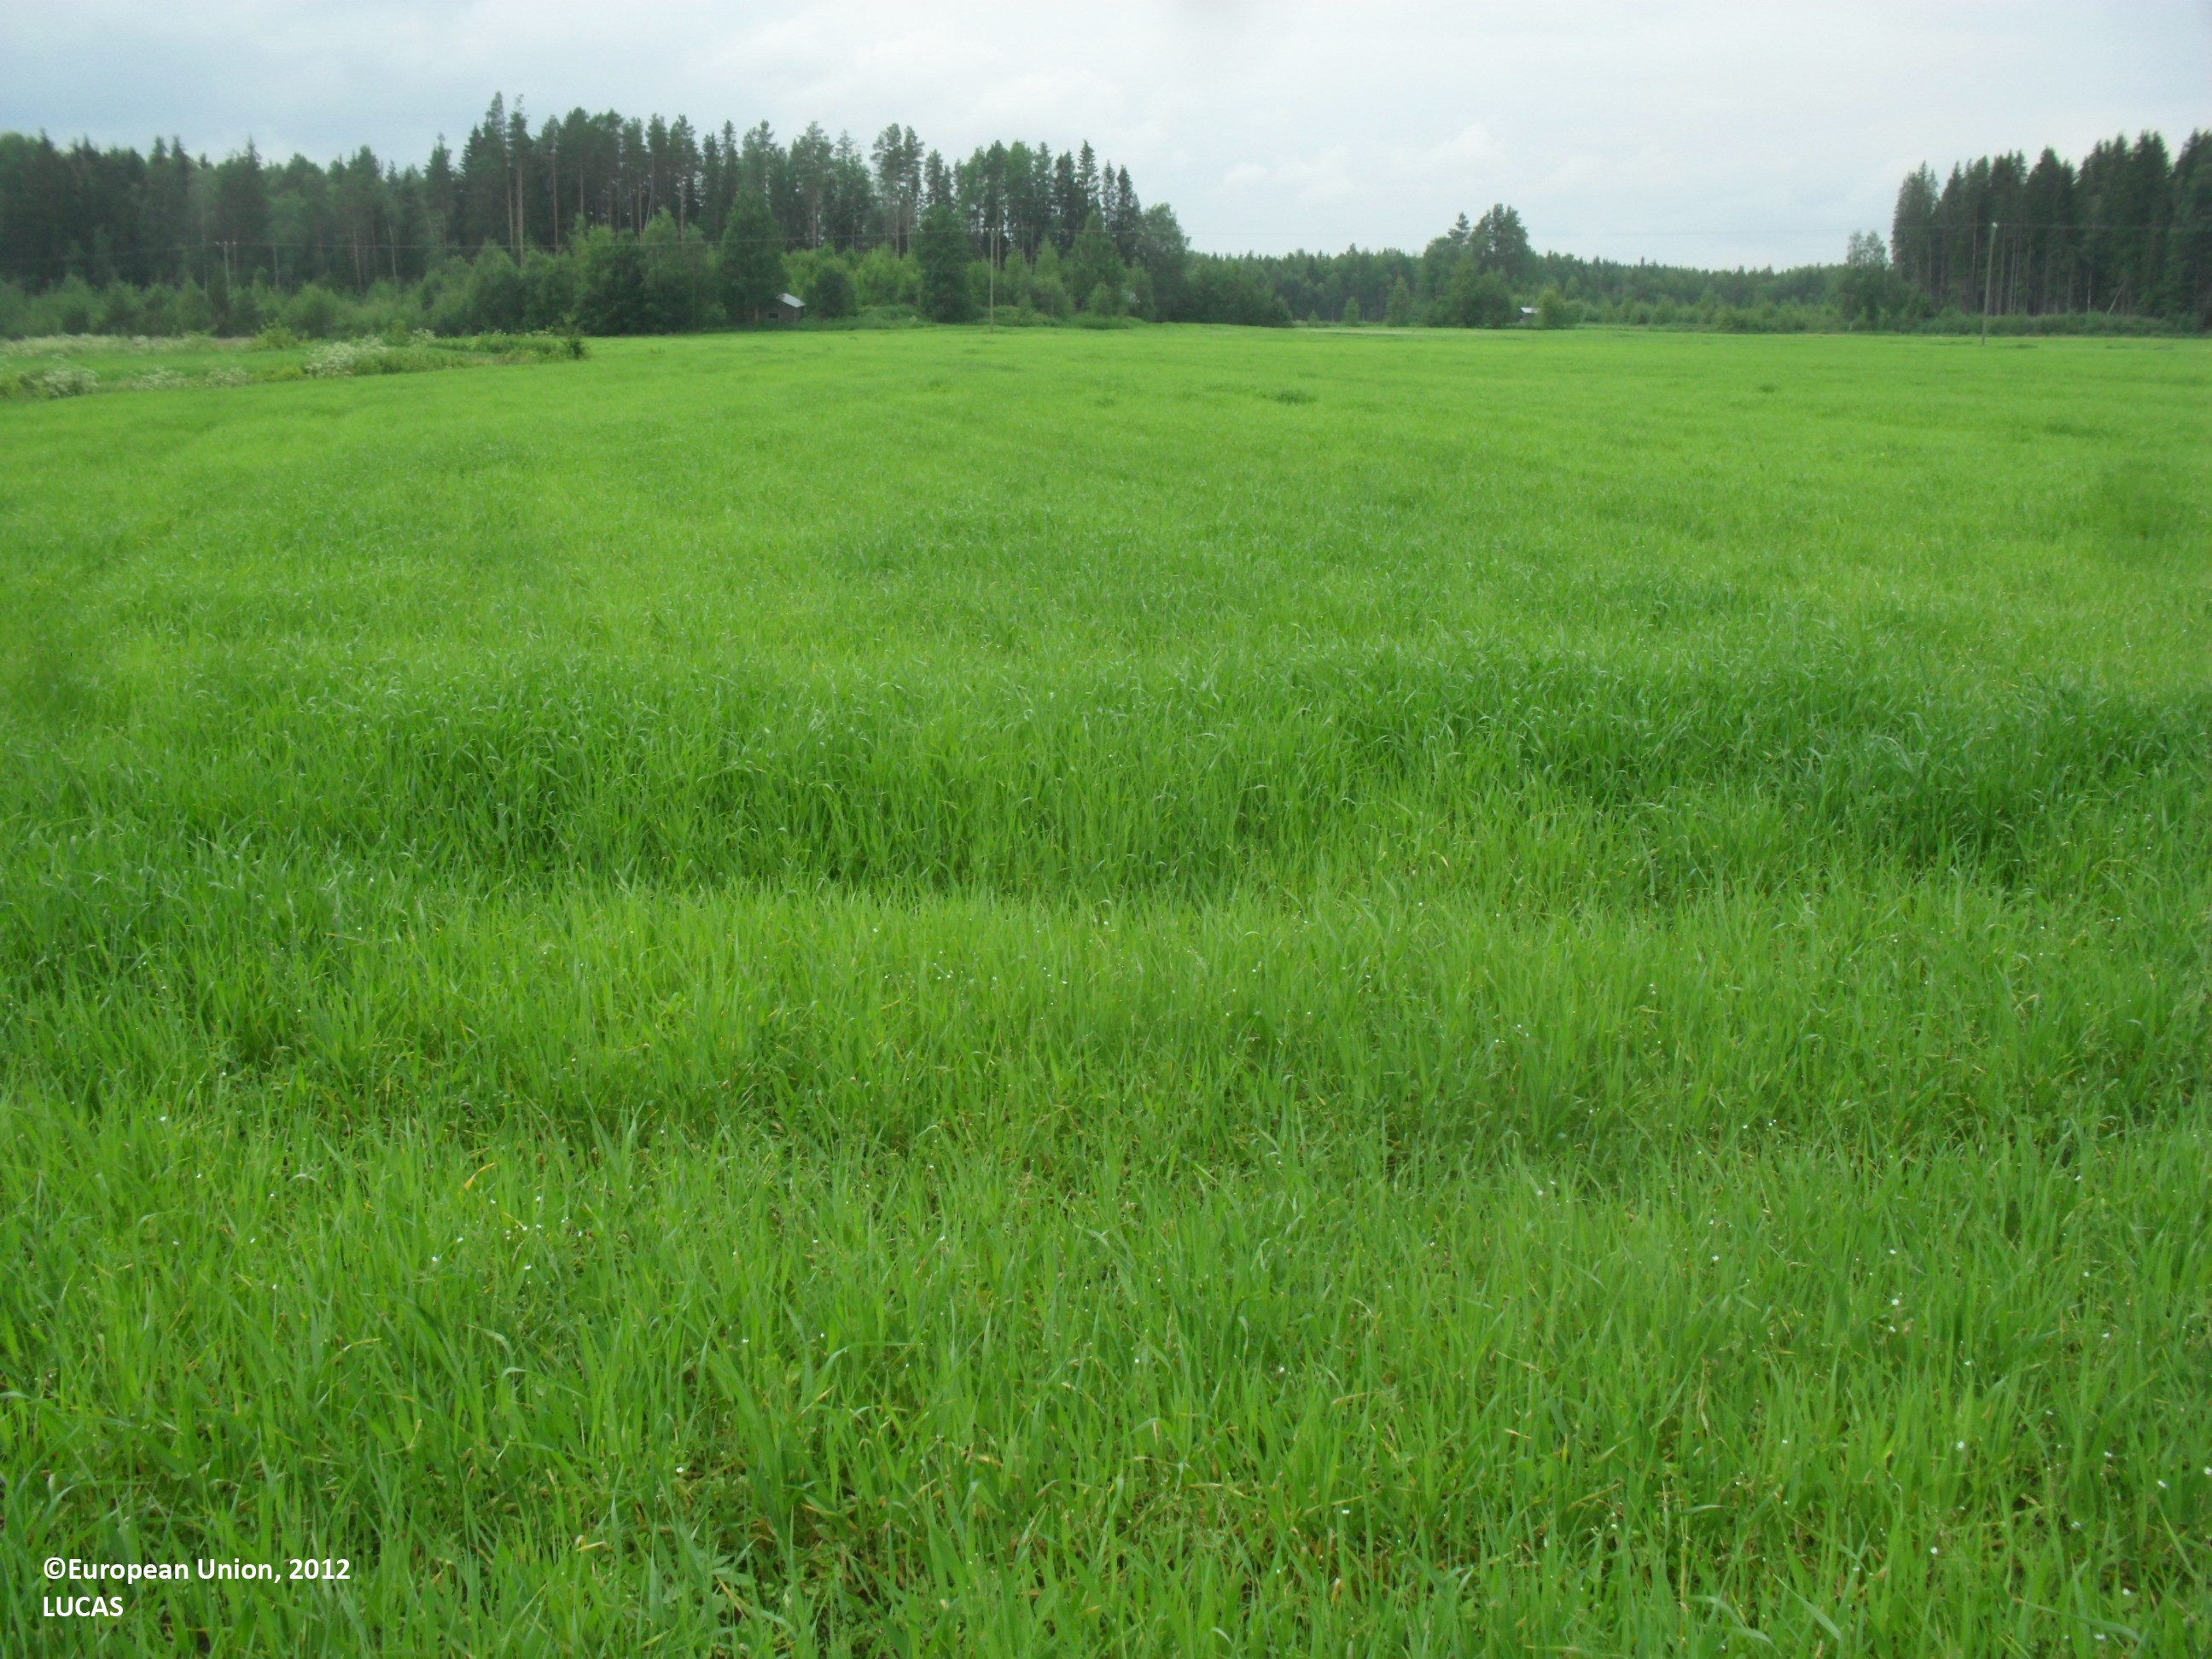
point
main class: Cropland
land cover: Barley
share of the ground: > 75 %
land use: Agriculture (excluding fallow land and kitchen gardens)
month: July
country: FI
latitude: 63.5971
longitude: 23.5053
